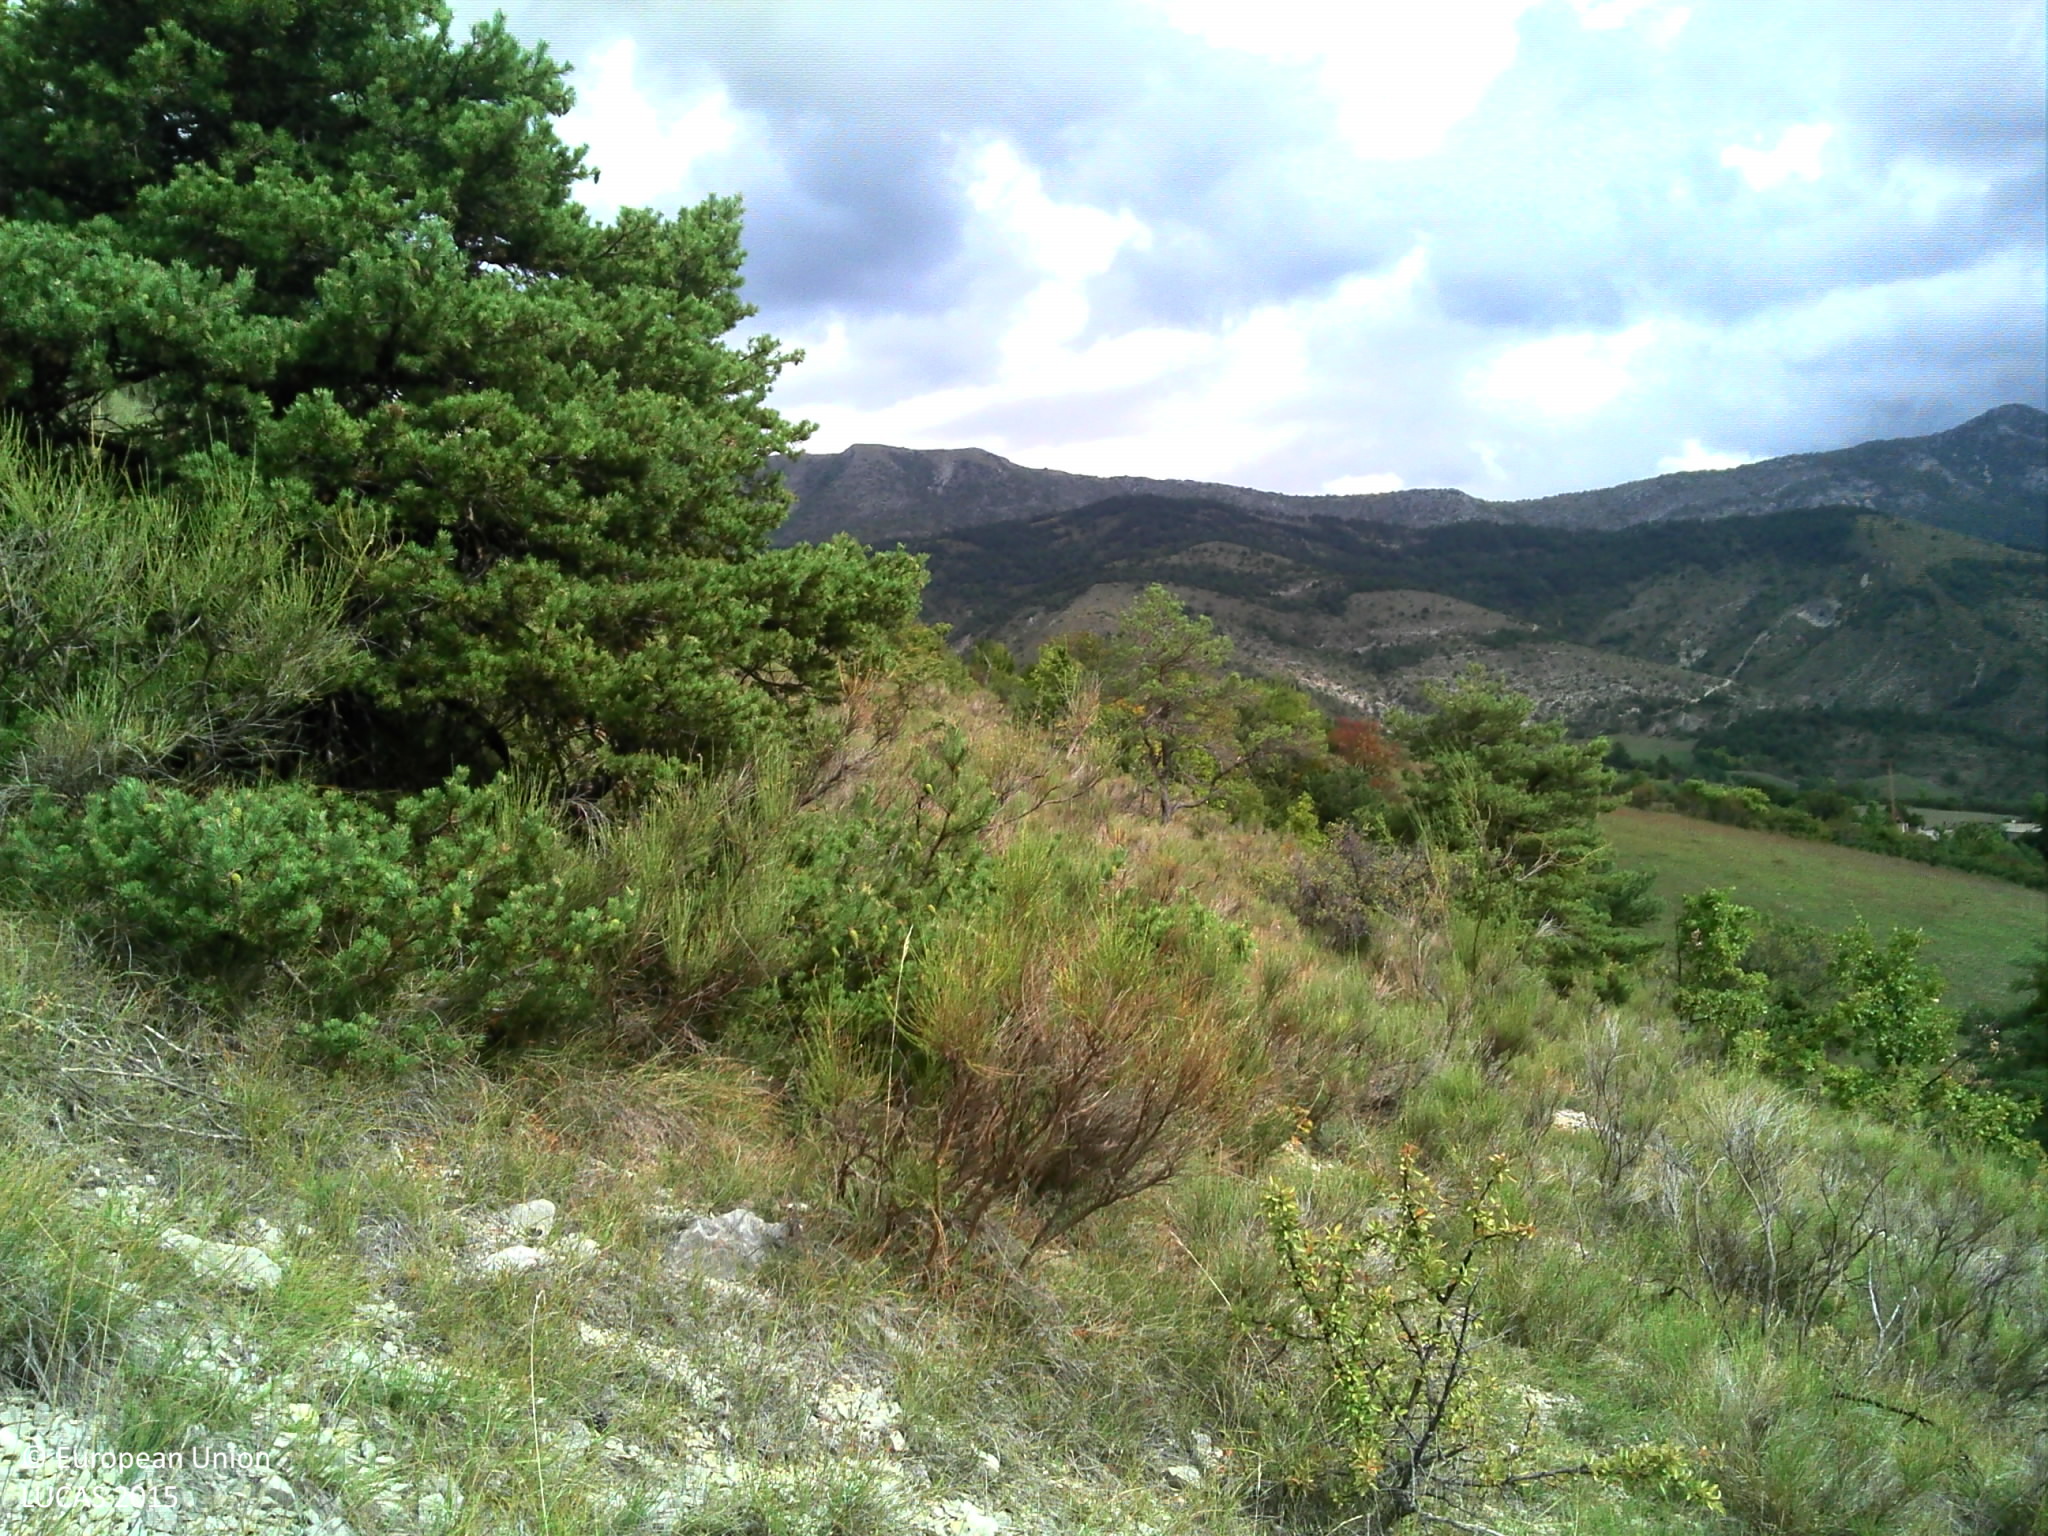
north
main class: Shrubland
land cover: Shrubland with sparse tree cover
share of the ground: 25 - 50 %
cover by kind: shrubs 55 %, herbaceous plants 20 %, consolidated bare surface 20 %, broadleaved forest trees 5 %
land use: Semi-natural and natural areas not in use
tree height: > 5 m
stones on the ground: 10 - 25 %
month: September
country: FR
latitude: 44.3975
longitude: 5.5000
